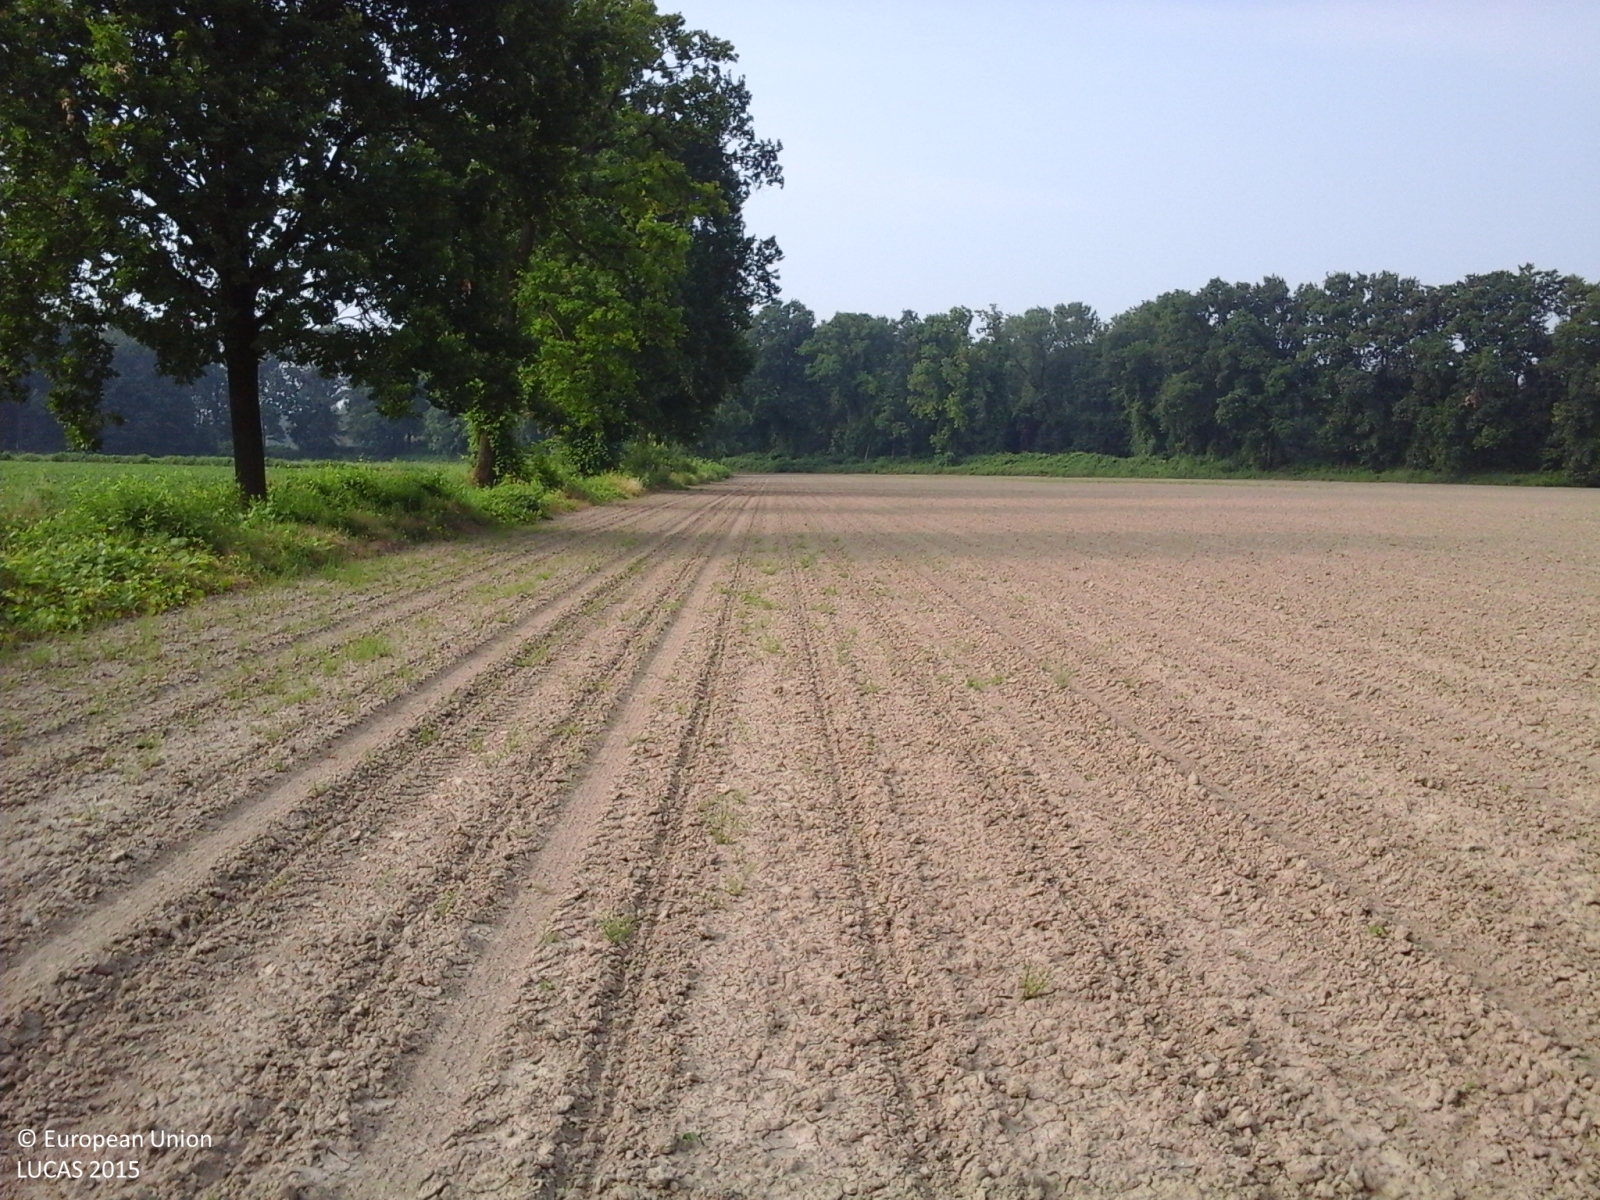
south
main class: Cropland
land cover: Maize
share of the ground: < 10 %
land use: Agriculture (excluding fallow land and kitchen gardens)
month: June
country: IT
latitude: 45.0538
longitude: 10.0127
